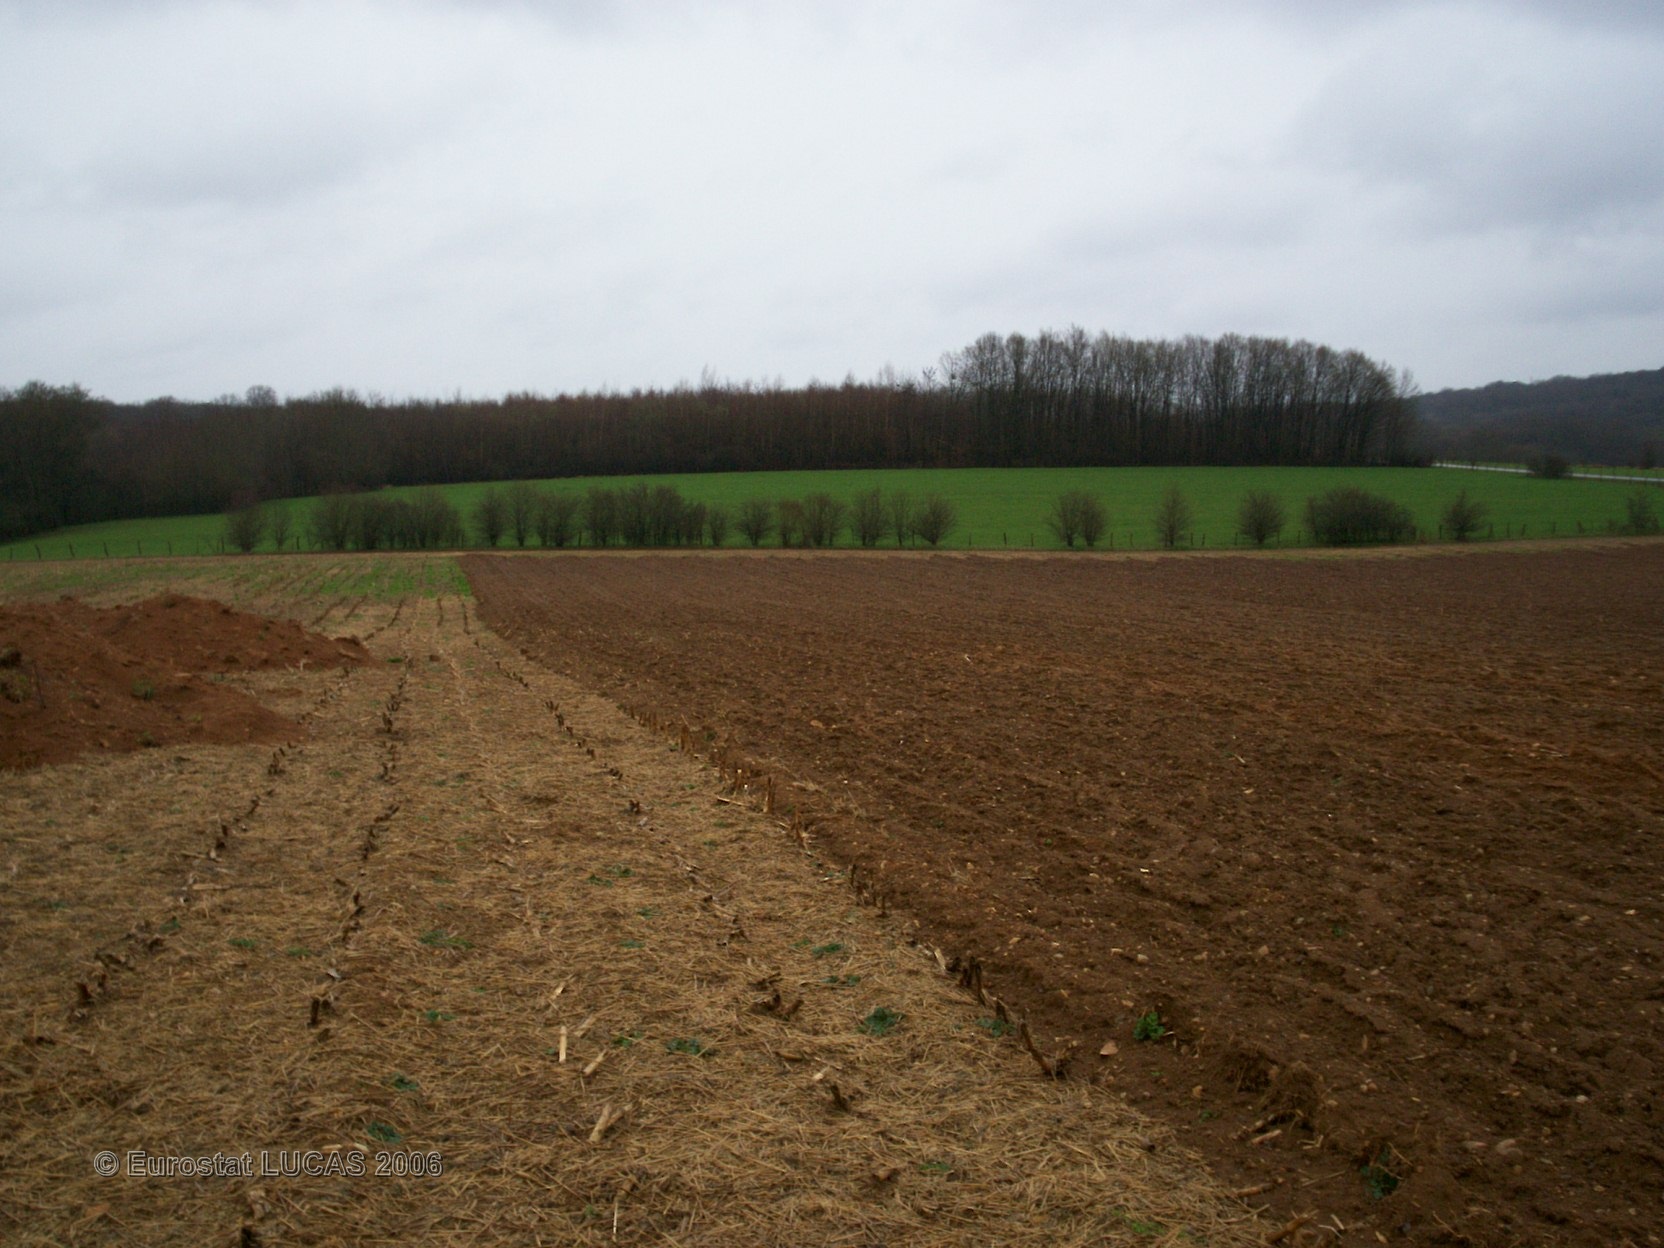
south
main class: Cropland
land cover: Maize
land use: Agriculture (excluding fallow land and kitchen gardens)
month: May
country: FR
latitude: 47.6386
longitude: 6.2878
